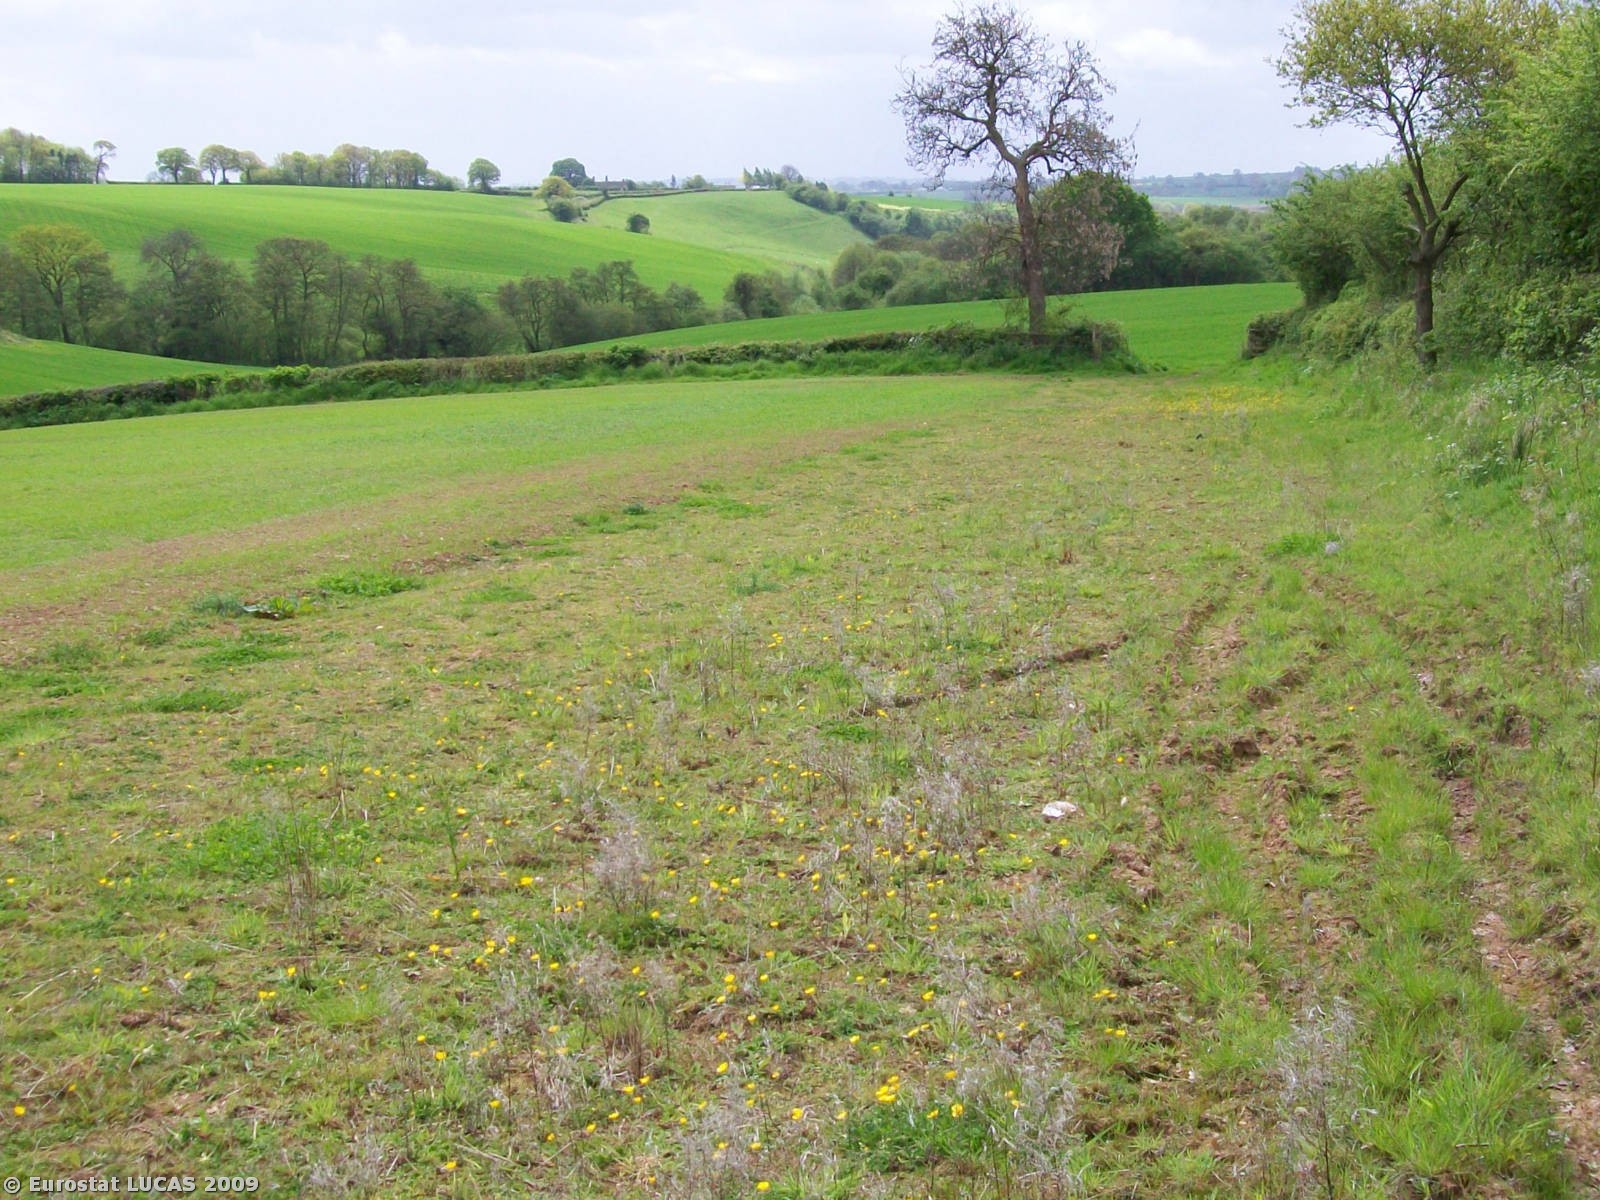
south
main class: Grassland
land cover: Grassland without tree/shrub cover
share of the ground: > 75 %
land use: Agriculture (excluding fallow land and kitchen gardens)
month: May
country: GB
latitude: 52.4242
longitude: -2.4923
